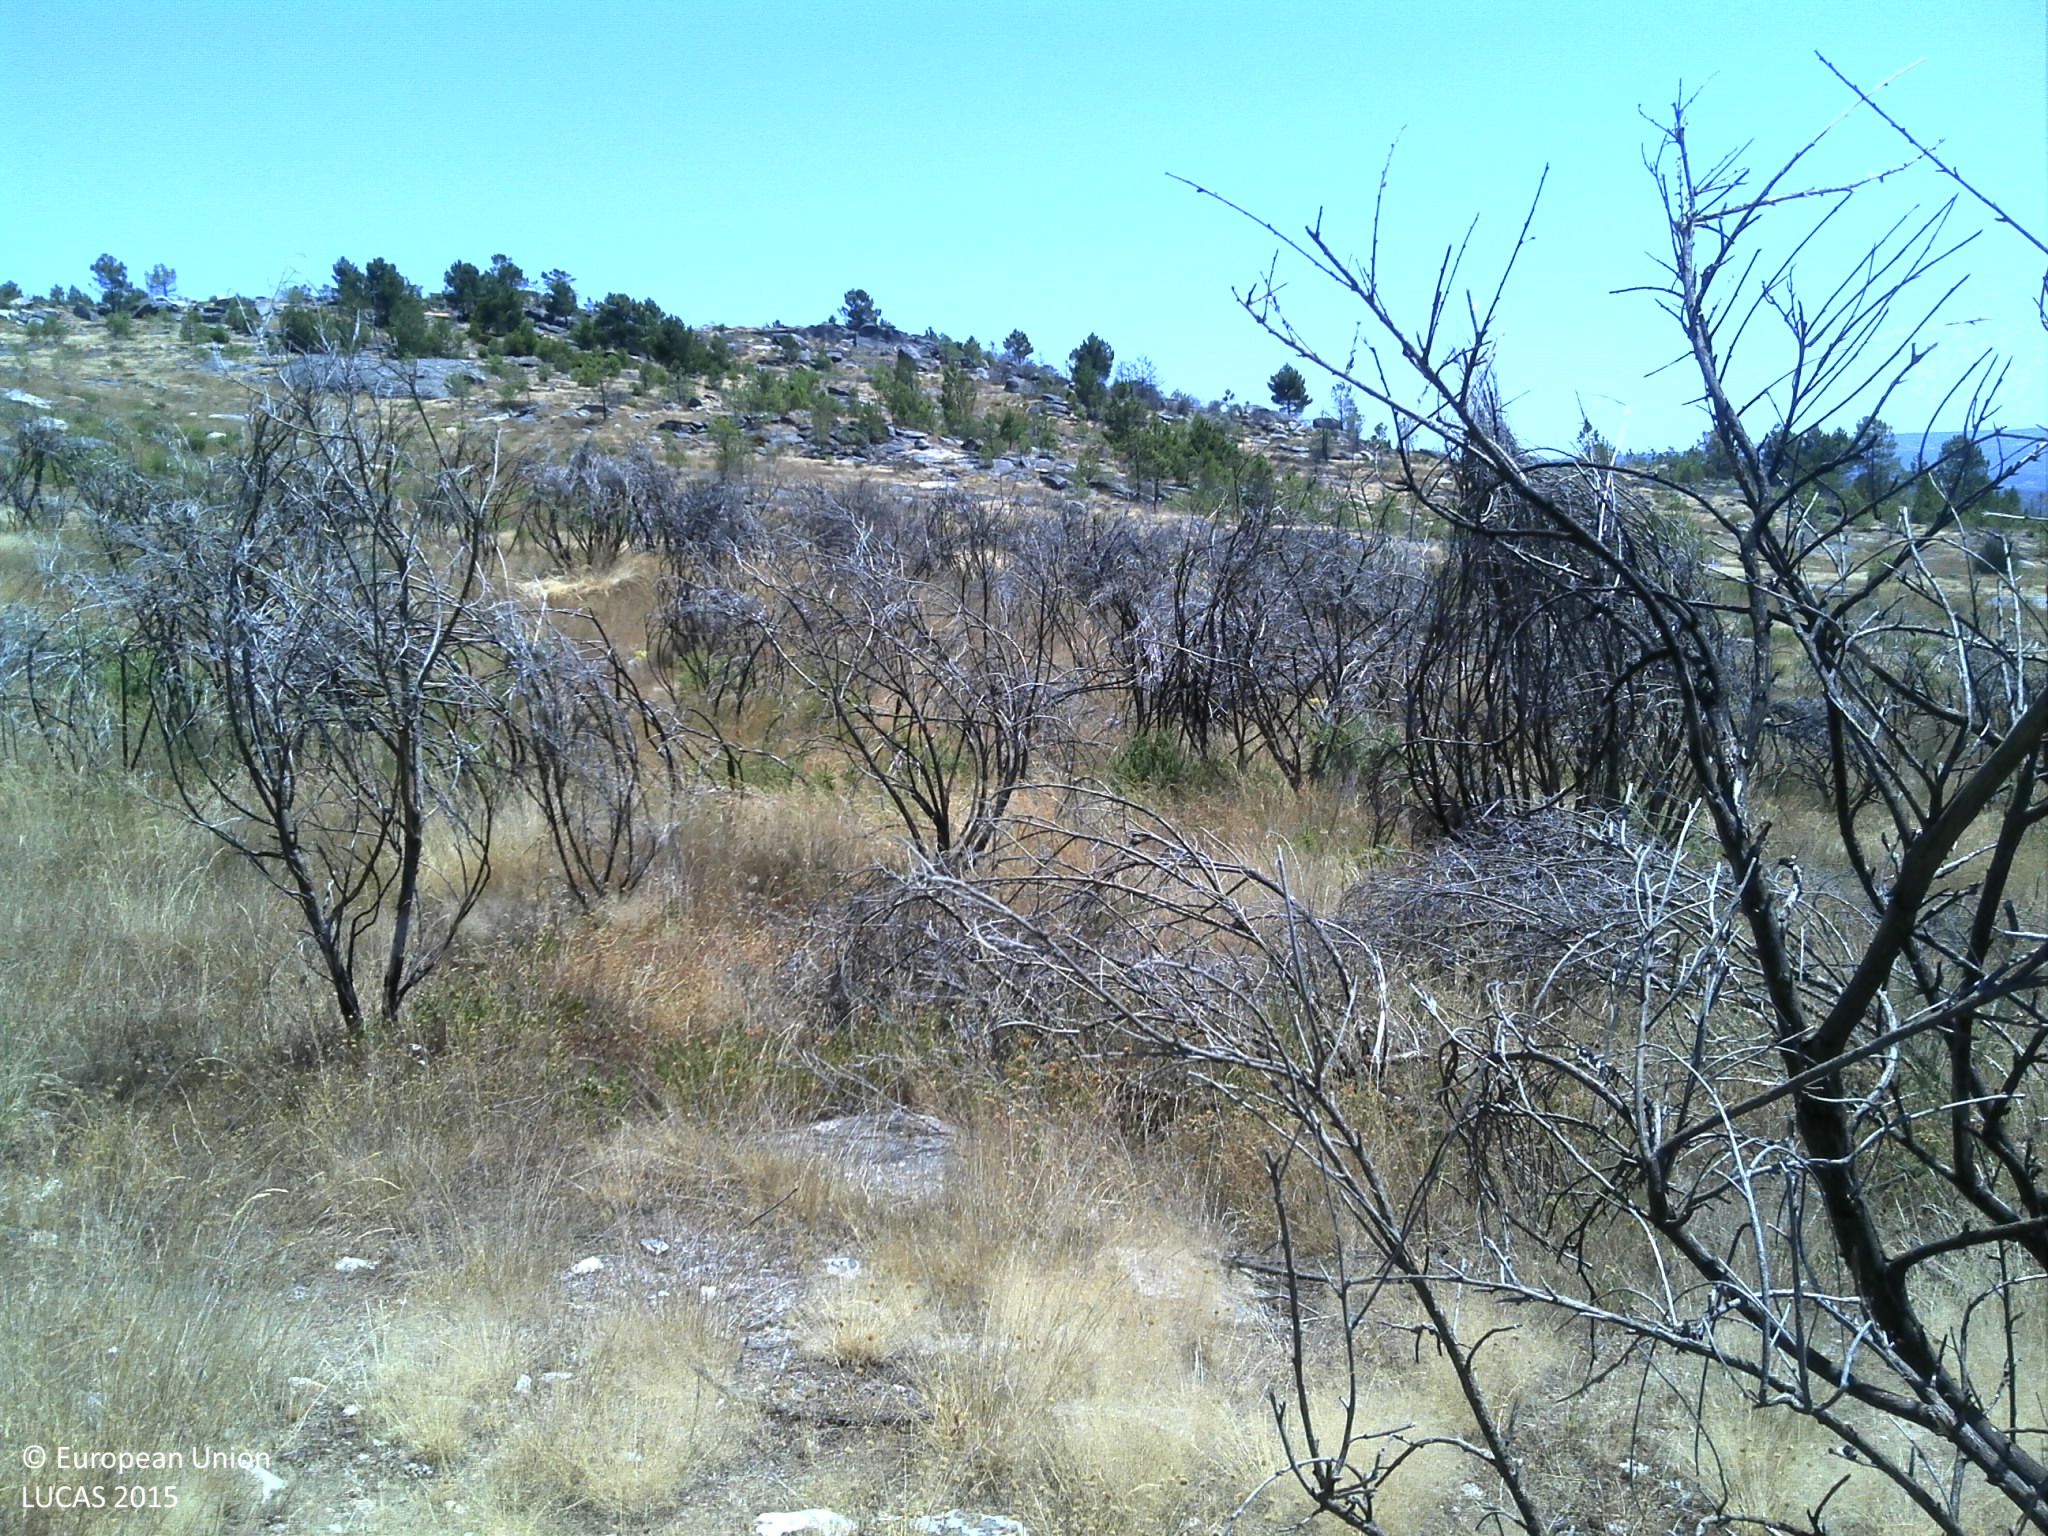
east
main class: Shrubland
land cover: Shrubland with sparse tree cover
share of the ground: 25 - 50 %
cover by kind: consolidated bare surface 30 %, shrubs 25 %, herbaceous plants 20 %, unconsolidated bare surface 20 %, coniferous forest trees 5 %
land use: Forestry
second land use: Agriculture (excluding fallow land and kitchen gardens)
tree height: < 5 m
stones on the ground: 10 - 25 %
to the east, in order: Shrubland with sparse tree cover; Shrubland without tree cover; Rock outcrops; Shrubland with sparse tree cover; Rock outcrops; Shrubland without tree cover; Shrubland with sparse tree cover; Rock outcrops
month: July
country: PT
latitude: 41.7129
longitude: -7.6707
